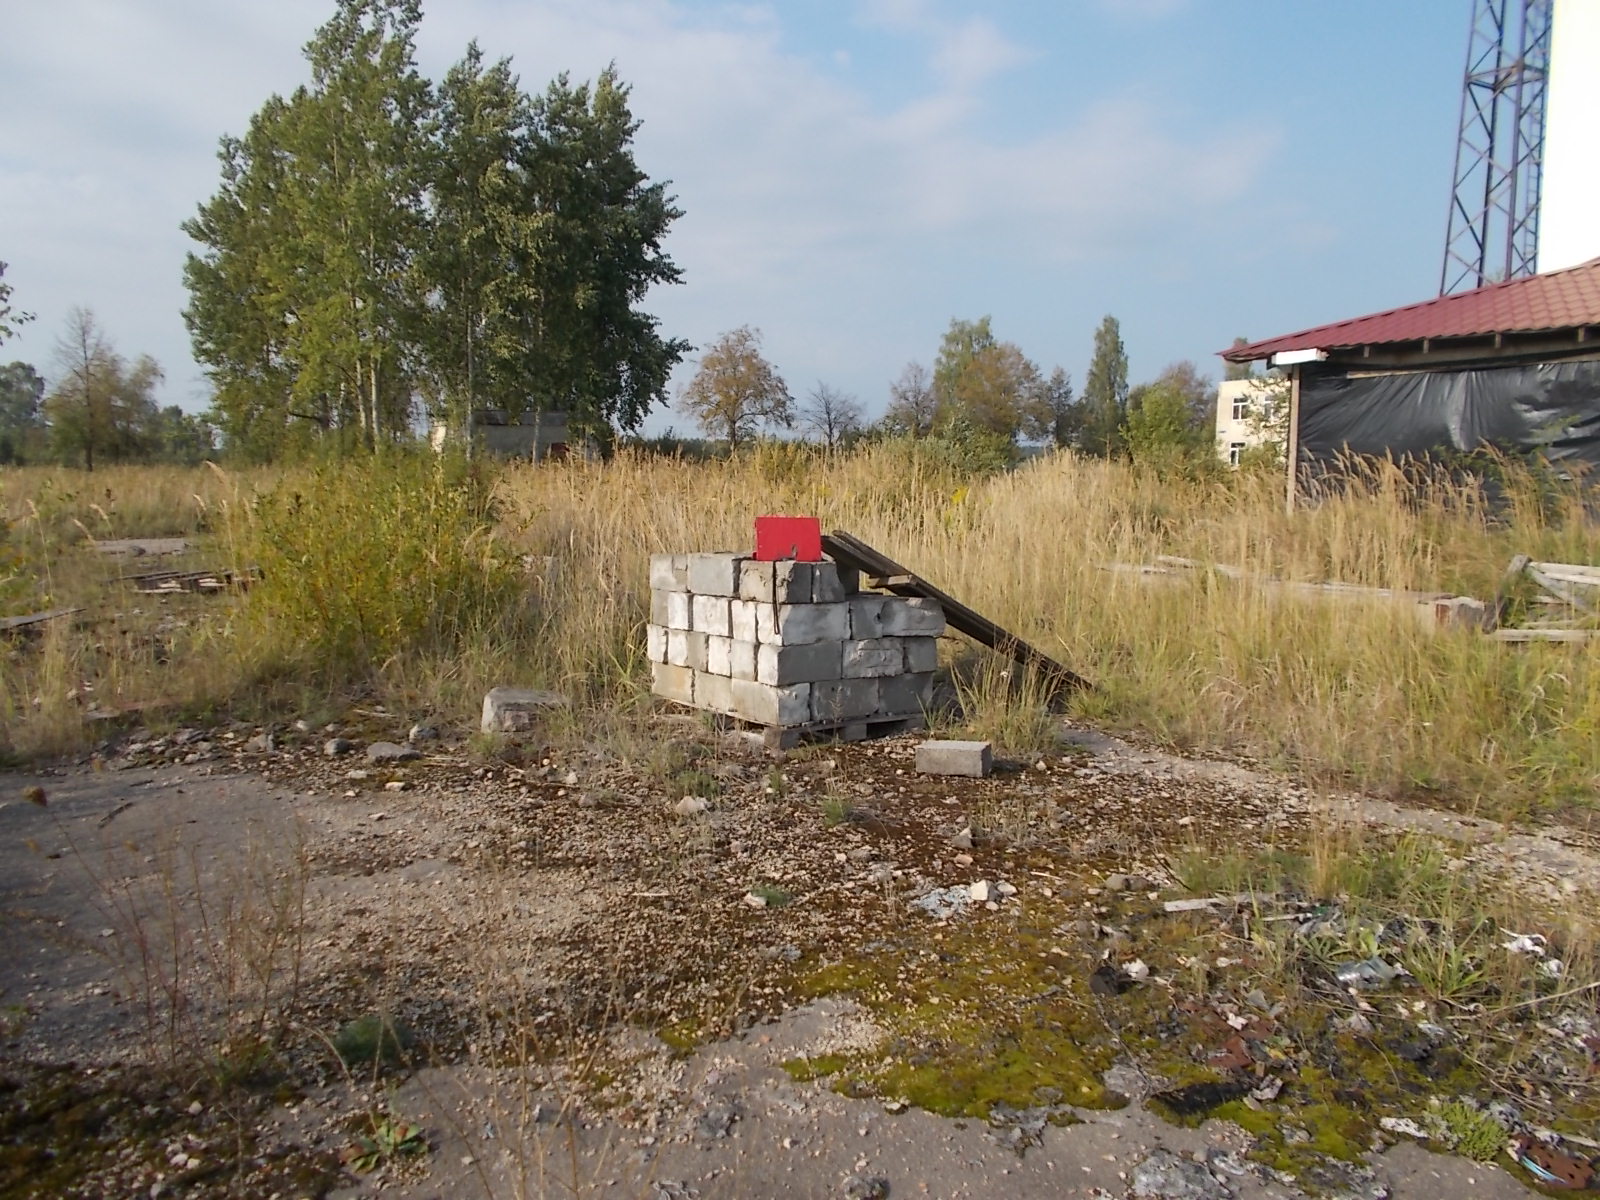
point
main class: Grassland
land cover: Spontaneously vegetated surfaces
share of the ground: 25 - 50 %
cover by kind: herbaceous plants 35 %
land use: Abandoned areas
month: September
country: LV
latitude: 56.9387
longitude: 23.6016
